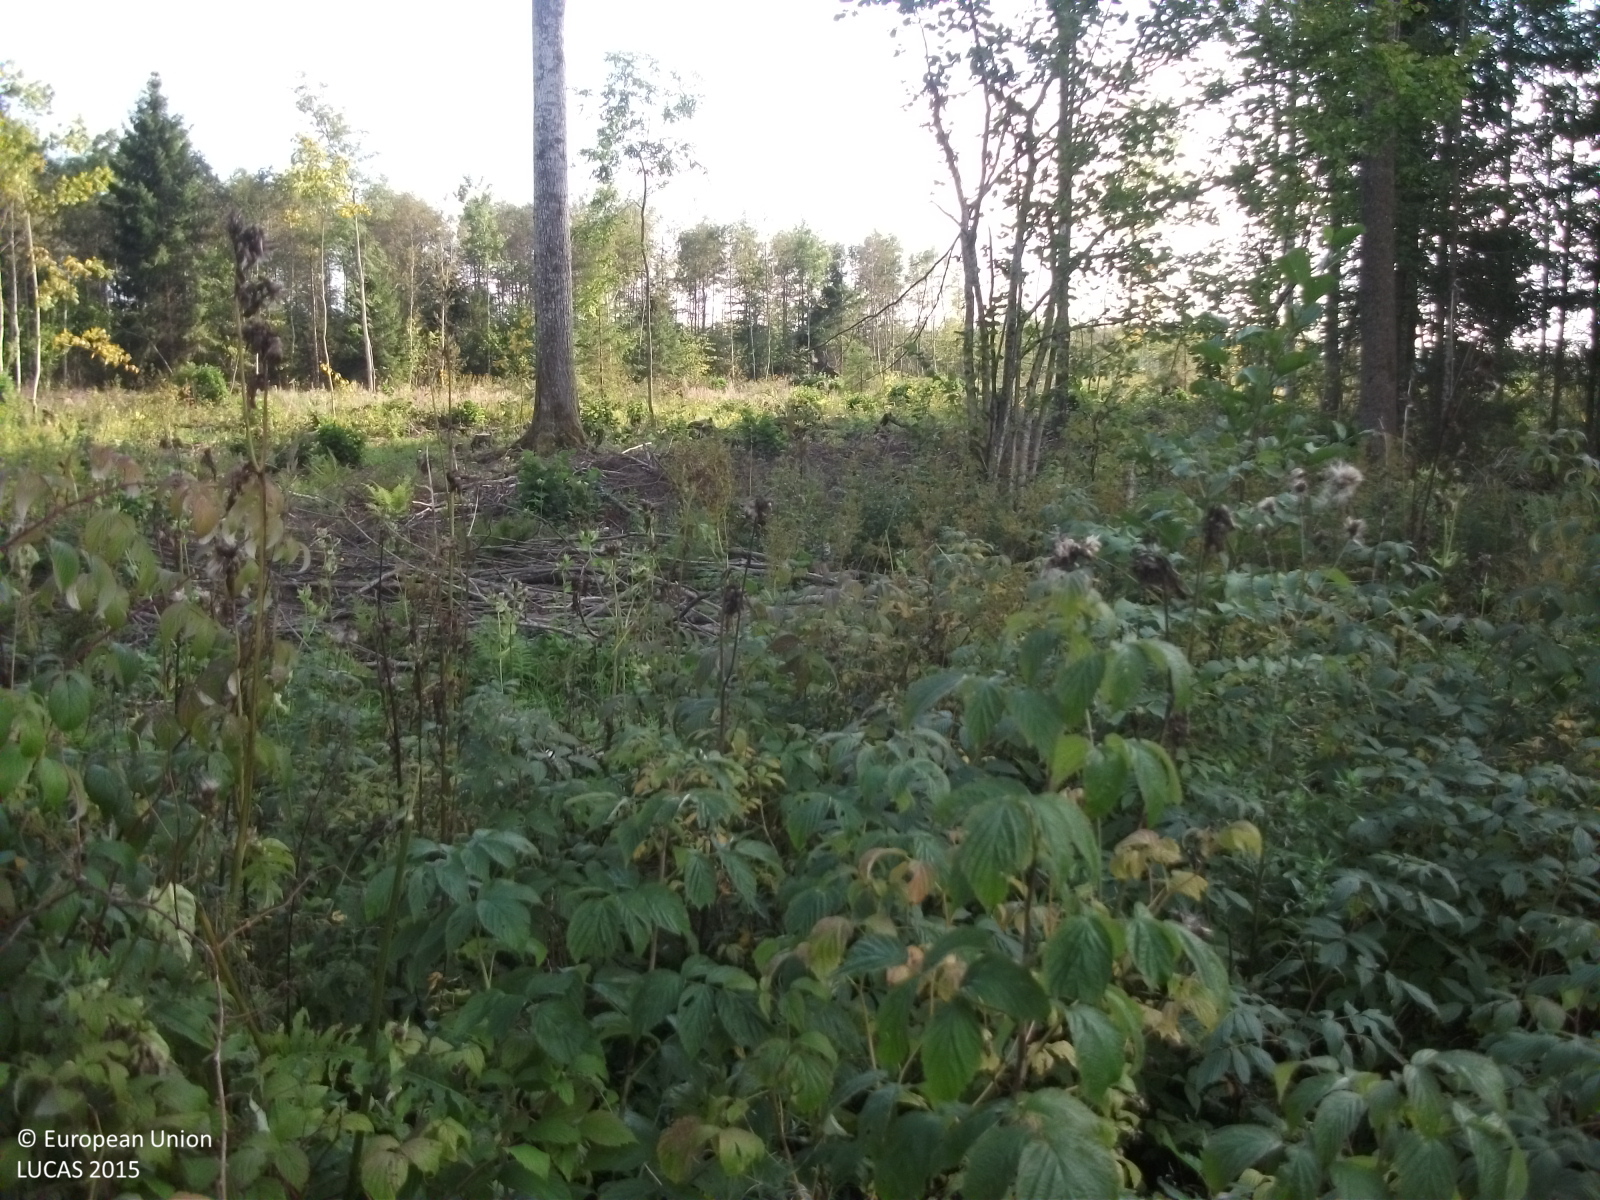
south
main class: Woodland
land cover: Broadleaved woodland
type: non-riverine alder, birch or aspen forest
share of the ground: 50 - 75 %
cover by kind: broadleaved forest trees 50 %, shrubs 35 %, herbaceous plants 10 %, coniferous forest trees 5 %
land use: Forestry
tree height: < 5 m
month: September
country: LV
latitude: 57.6065
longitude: 24.5344
